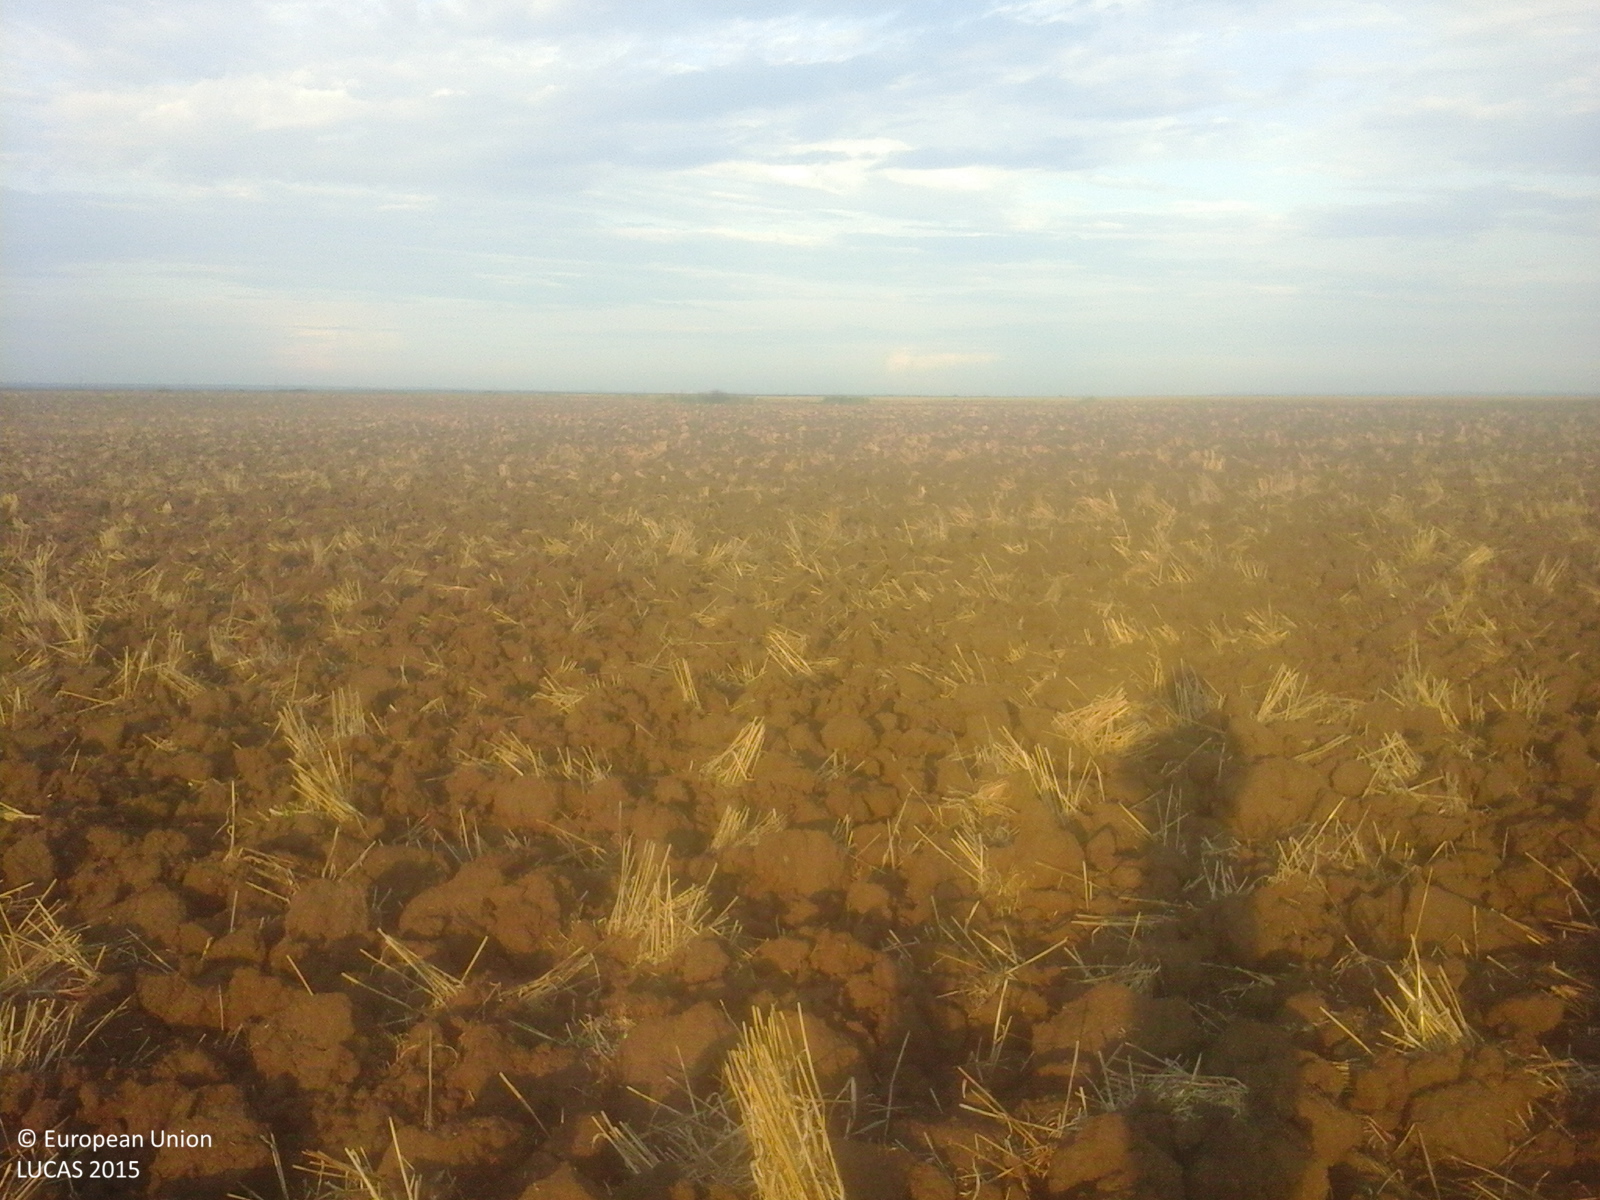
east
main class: Cropland
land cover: Common wheat
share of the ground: < 10 %
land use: Agriculture (excluding fallow land and kitchen gardens)
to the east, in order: Common wheat
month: July
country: RO
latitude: 43.8341
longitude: 24.5288
